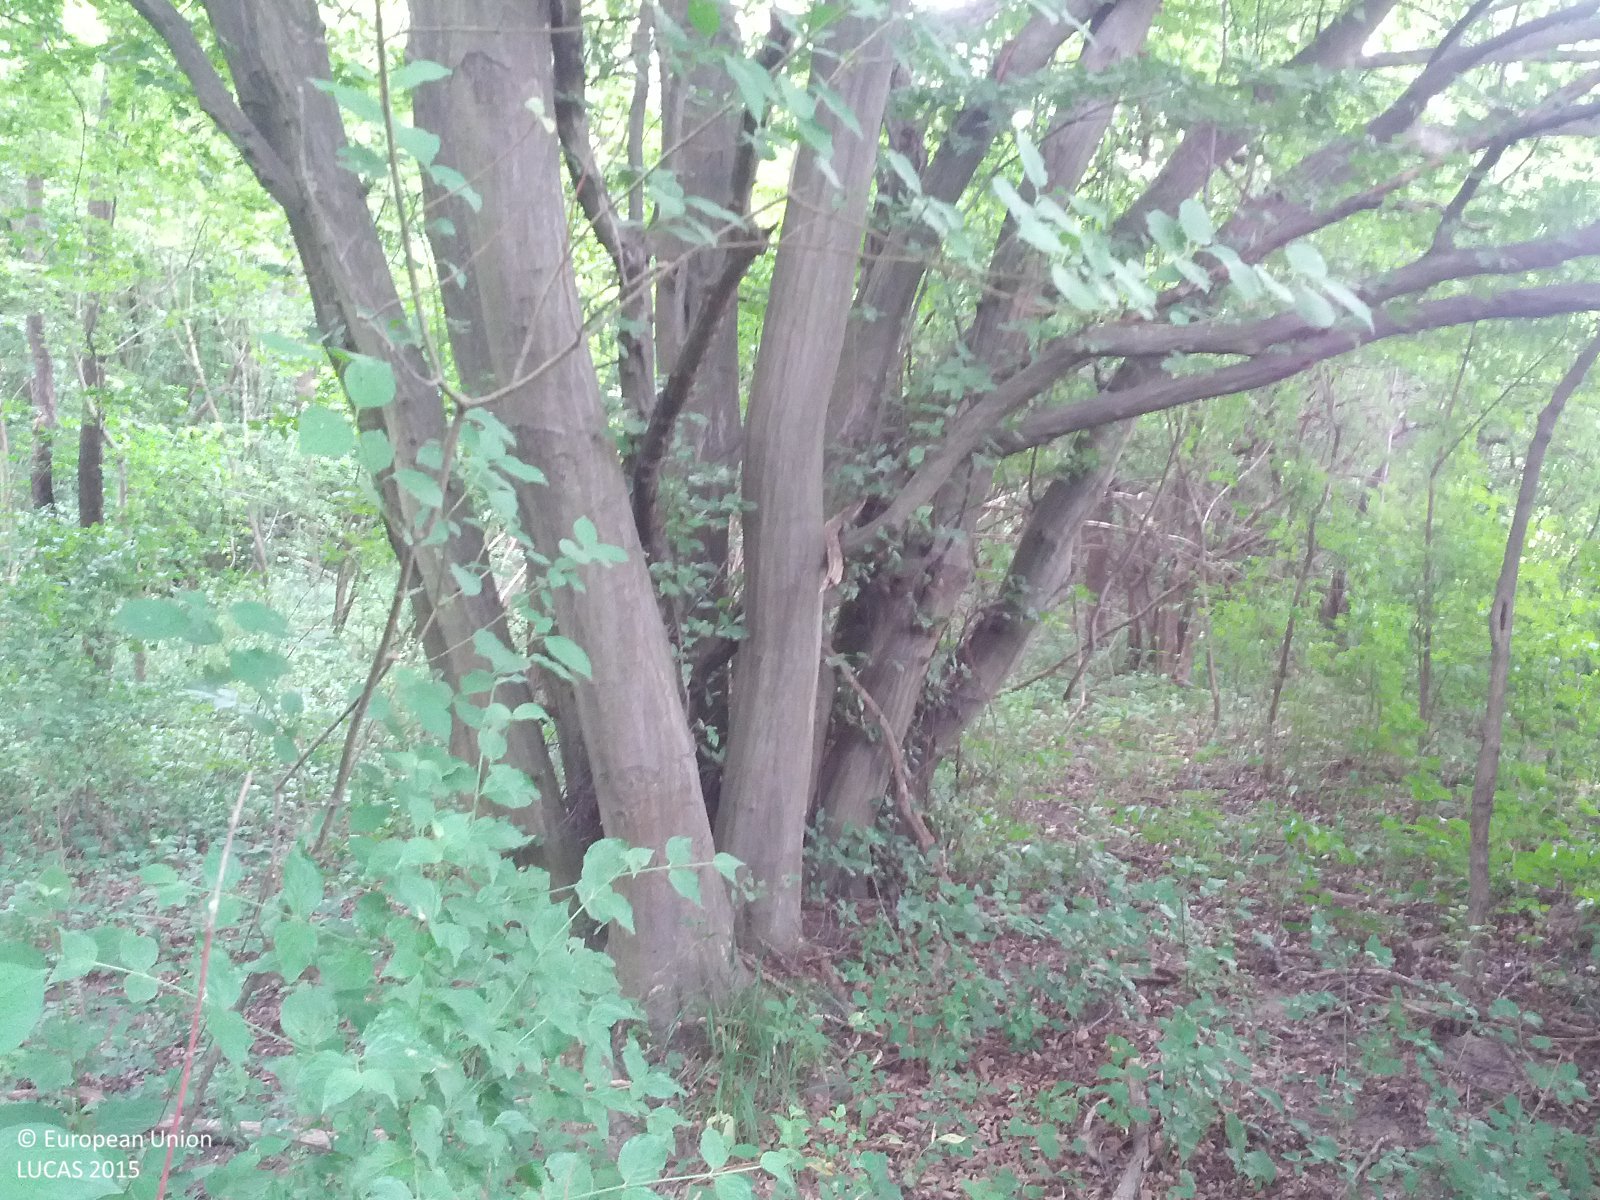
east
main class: Woodland
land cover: Broadleaved woodland
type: mesophytic deciduous forest
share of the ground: 50 - 75 %
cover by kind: broadleaved forest trees 60 %, shrubs 30 %, herbaceous plants 10 %
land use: Forestry
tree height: > 5 m
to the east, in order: Broadleaved woodland
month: June
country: AT
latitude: 48.1729
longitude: 16.5545
